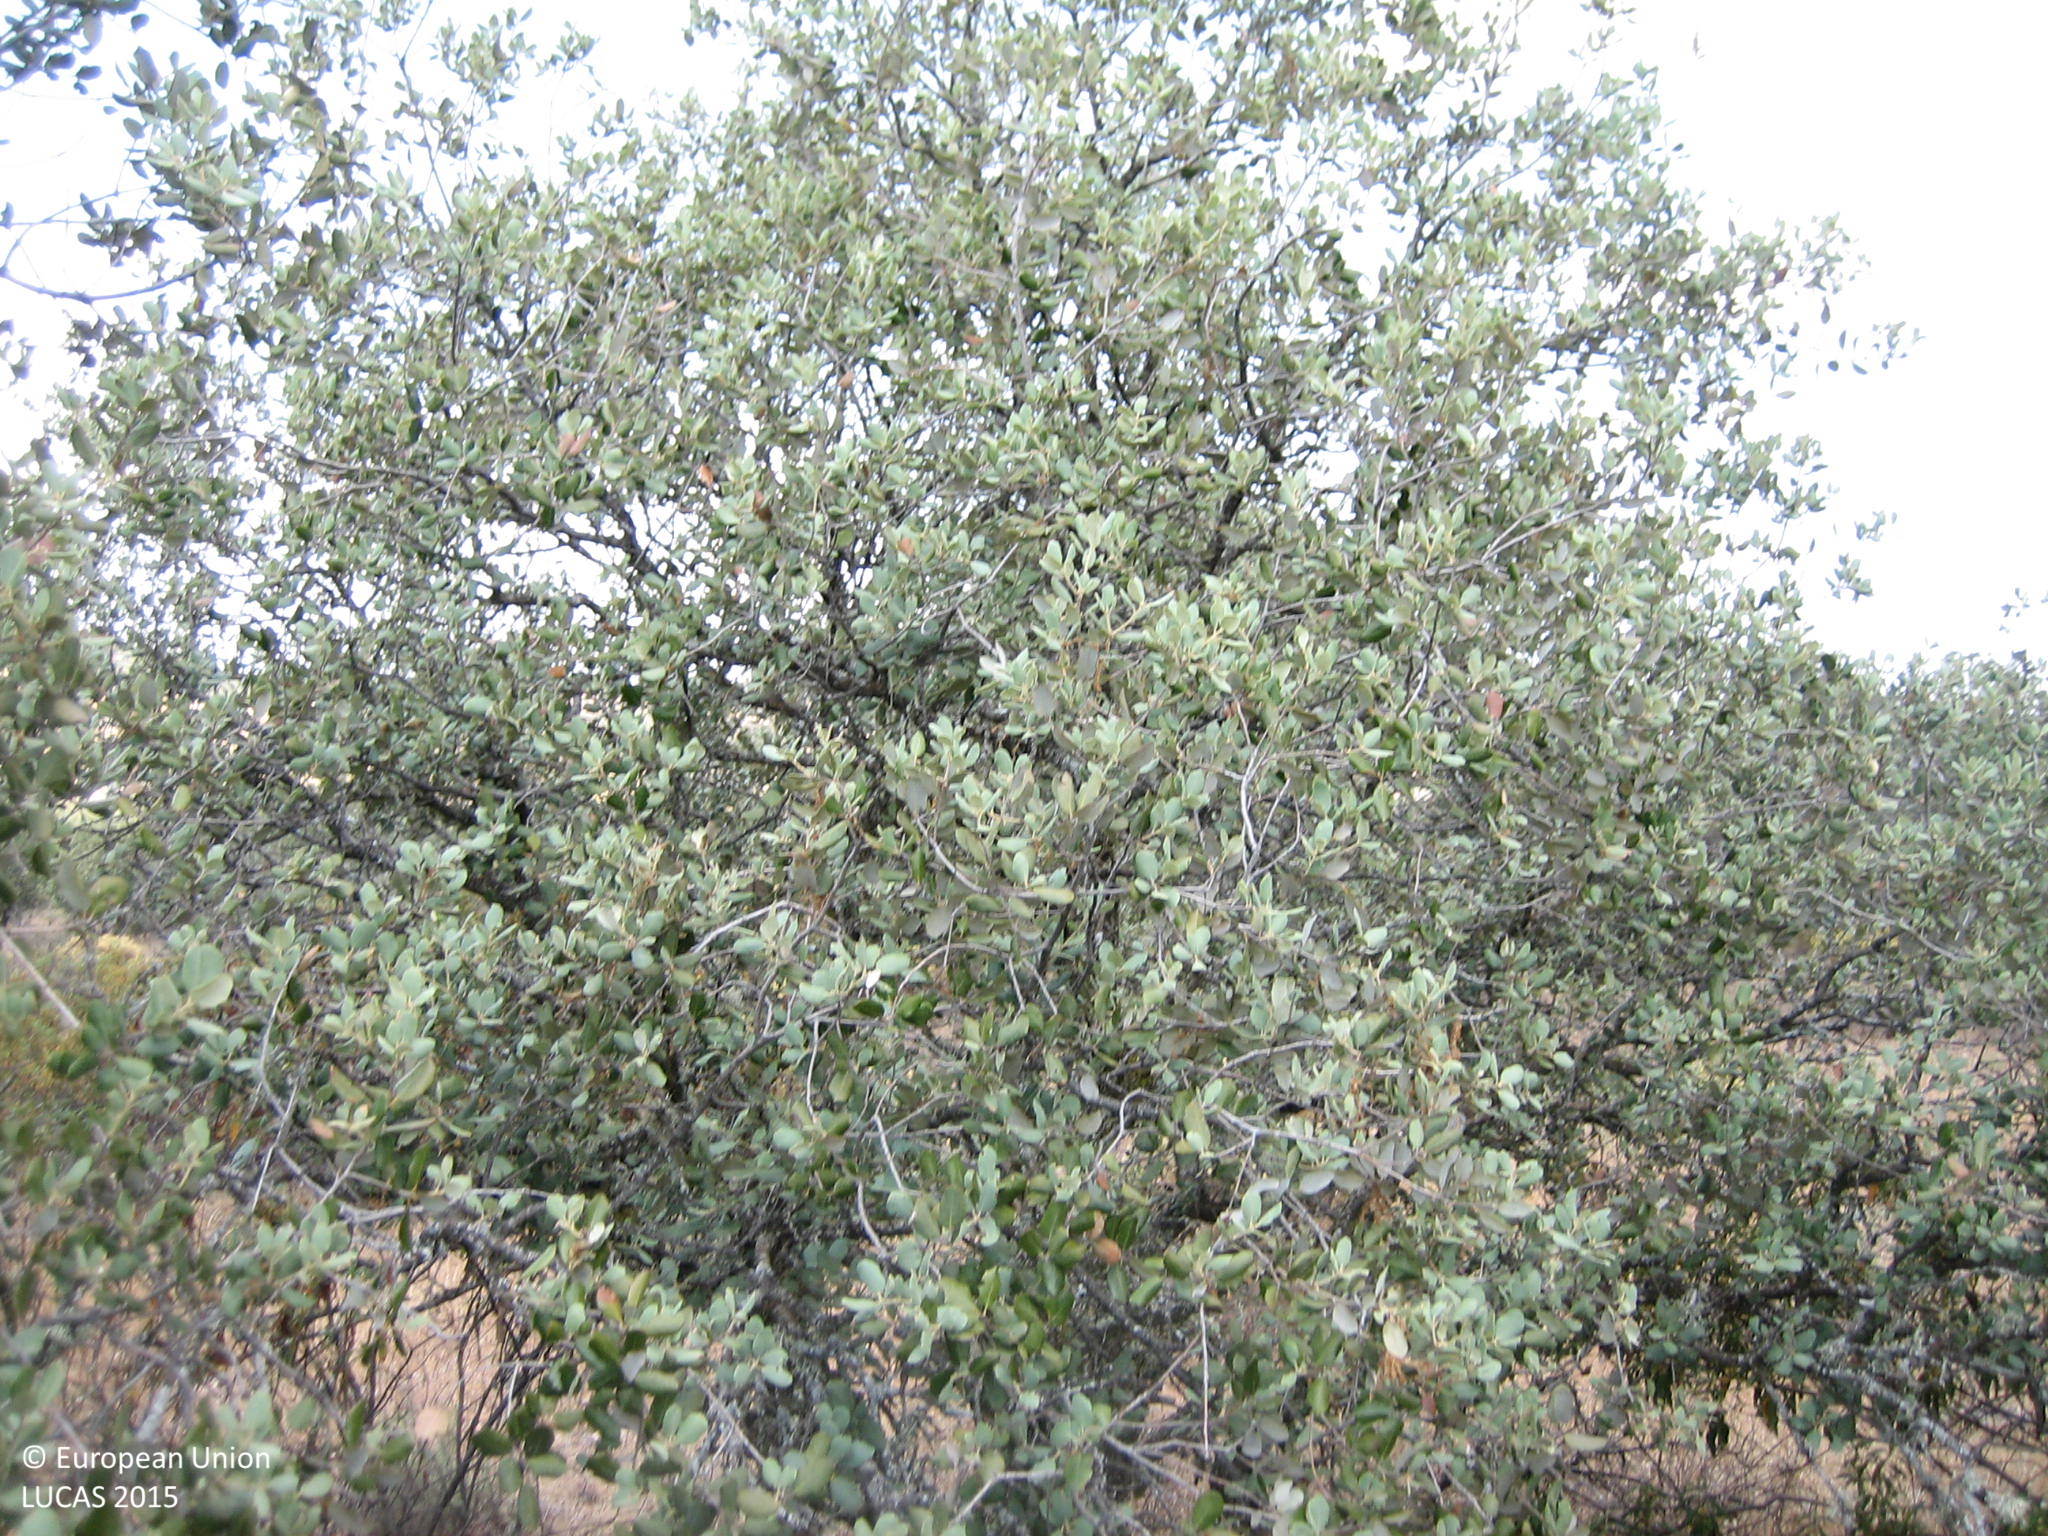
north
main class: Woodland
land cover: Broadleaved woodland
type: broadleaved evergreen forest
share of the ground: 50 - 75 %
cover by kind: broadleaved forest trees 70 %, herbaceous plants 30 %
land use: Semi-natural and natural areas not in use
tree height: < 5 m
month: May
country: ES
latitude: 38.8305
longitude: -4.0385
